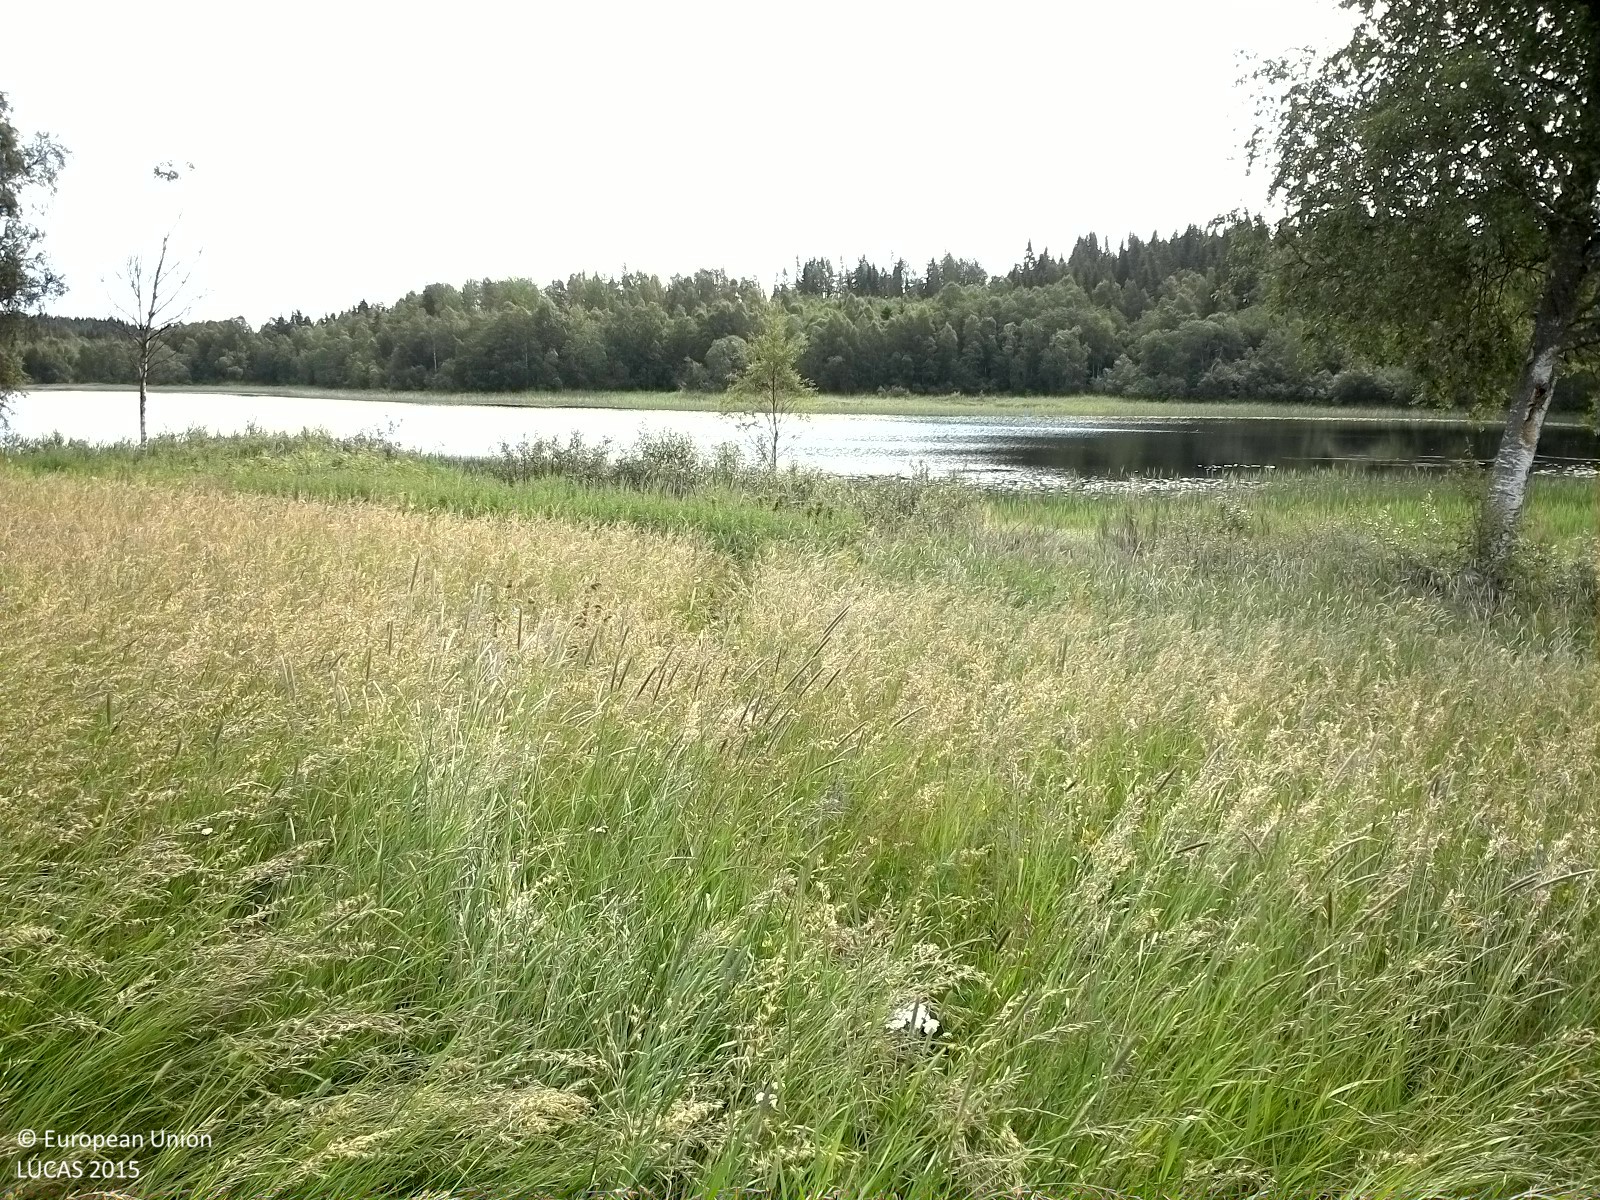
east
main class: Cropland
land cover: Other leguminous and mixtures for fodder
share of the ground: > 75 %
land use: Agriculture (excluding fallow land and kitchen gardens)
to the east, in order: Other leguminous and mixtures for fodder; Spontaneously vegetated surfaces; Abandoned hedges; Dry stone walls; Inland marshes; Inland fresh water bodies; Inland marshes; Broadleaved woodland
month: July
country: SE
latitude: 62.5103
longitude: 17.6121
